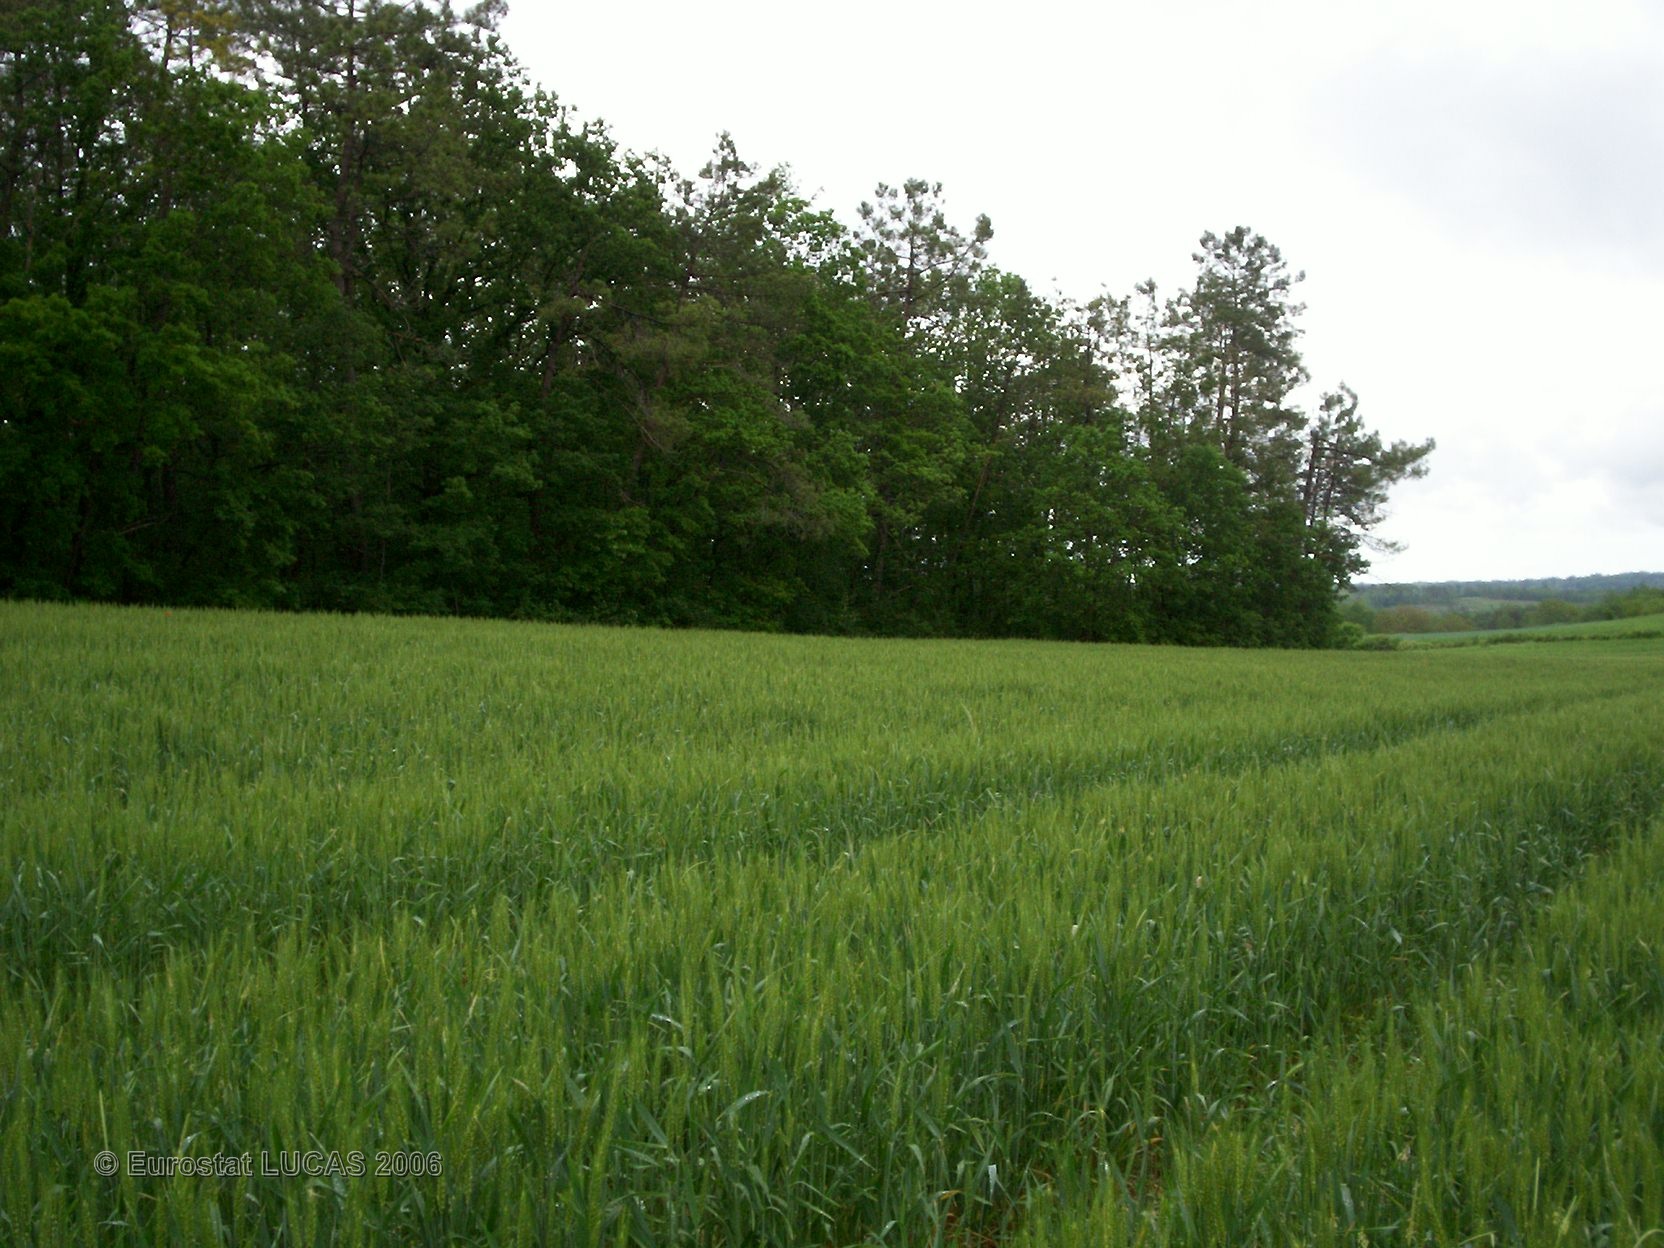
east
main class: Cropland
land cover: Triticale
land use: Agriculture (excluding fallow land and kitchen gardens)
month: May
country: FR
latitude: 45.3879
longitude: 0.5492
